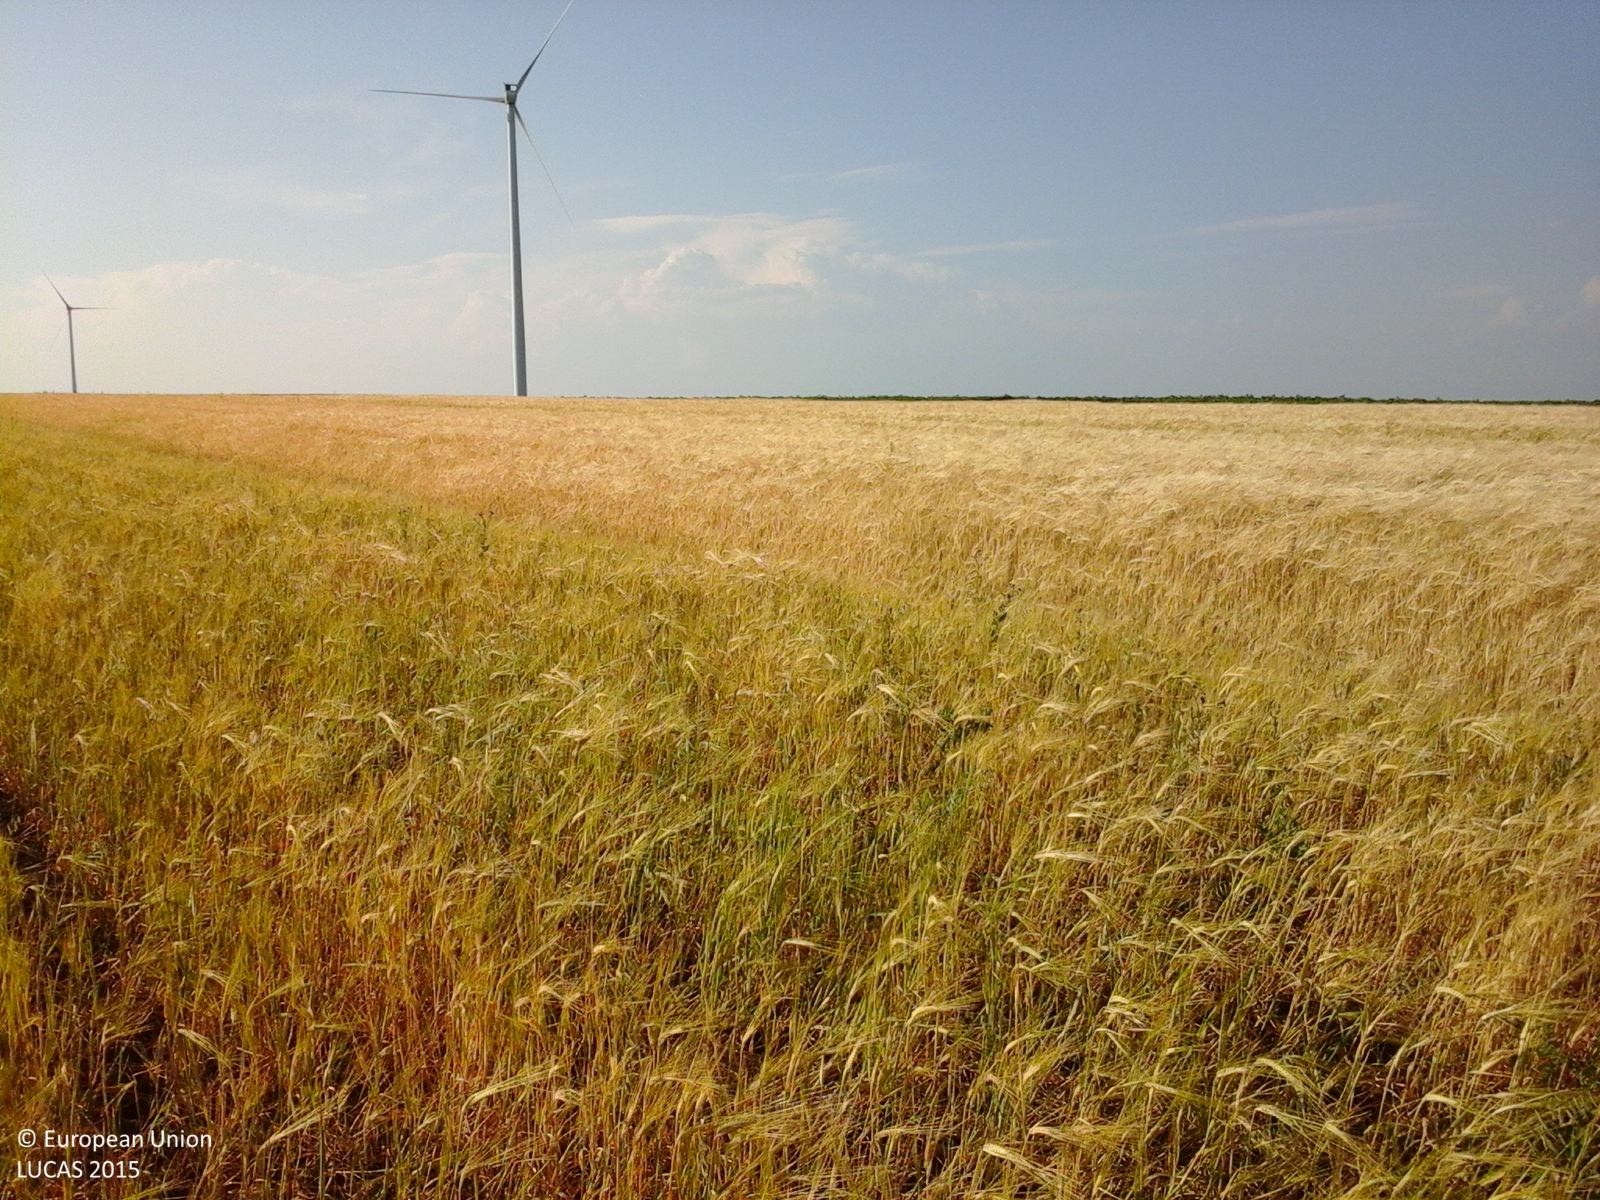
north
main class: Cropland
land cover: Barley
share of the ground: > 75 %
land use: Agriculture (excluding fallow land and kitchen gardens)
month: June
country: RO
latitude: 46.8011
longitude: 28.0958
